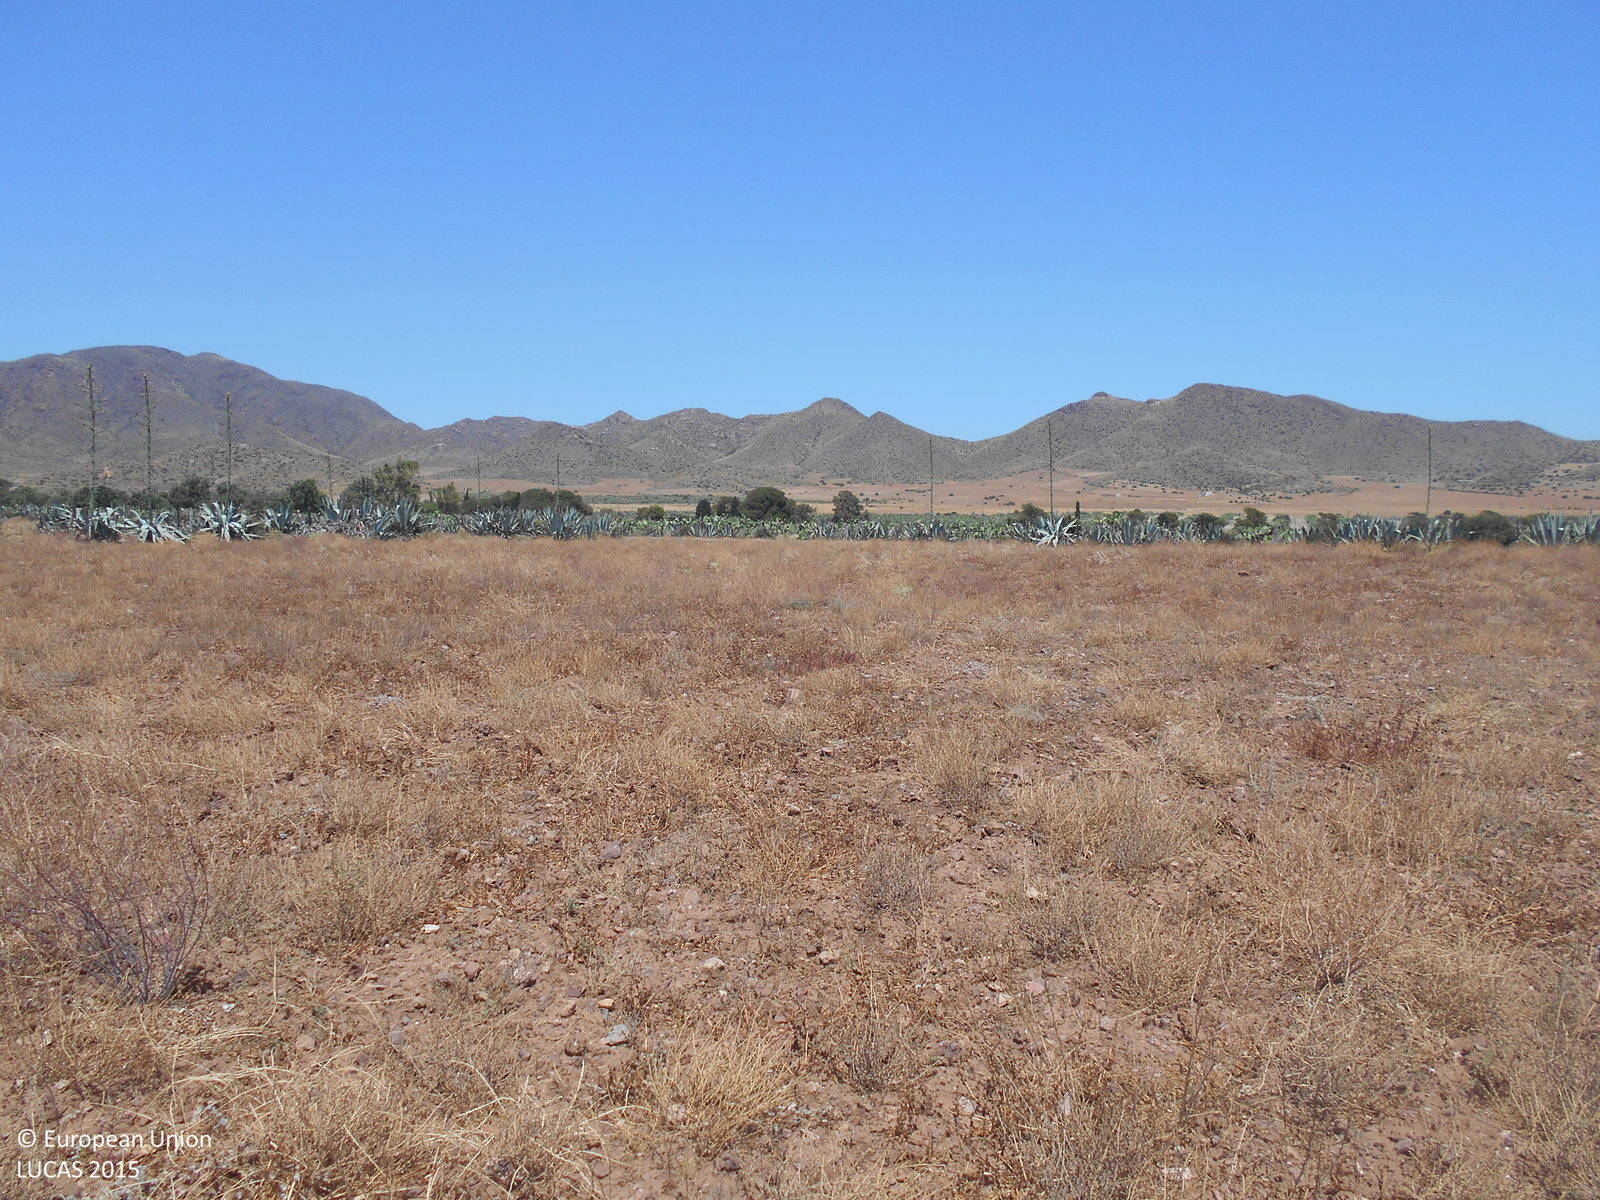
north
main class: Grassland
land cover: Grassland without tree/shrub cover
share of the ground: 25 - 50 %
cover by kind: unconsolidated bare surface 70 %, herbaceous plants 30 %
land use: Abandoned areas
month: May
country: ES
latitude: 36.7488
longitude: -2.1242
